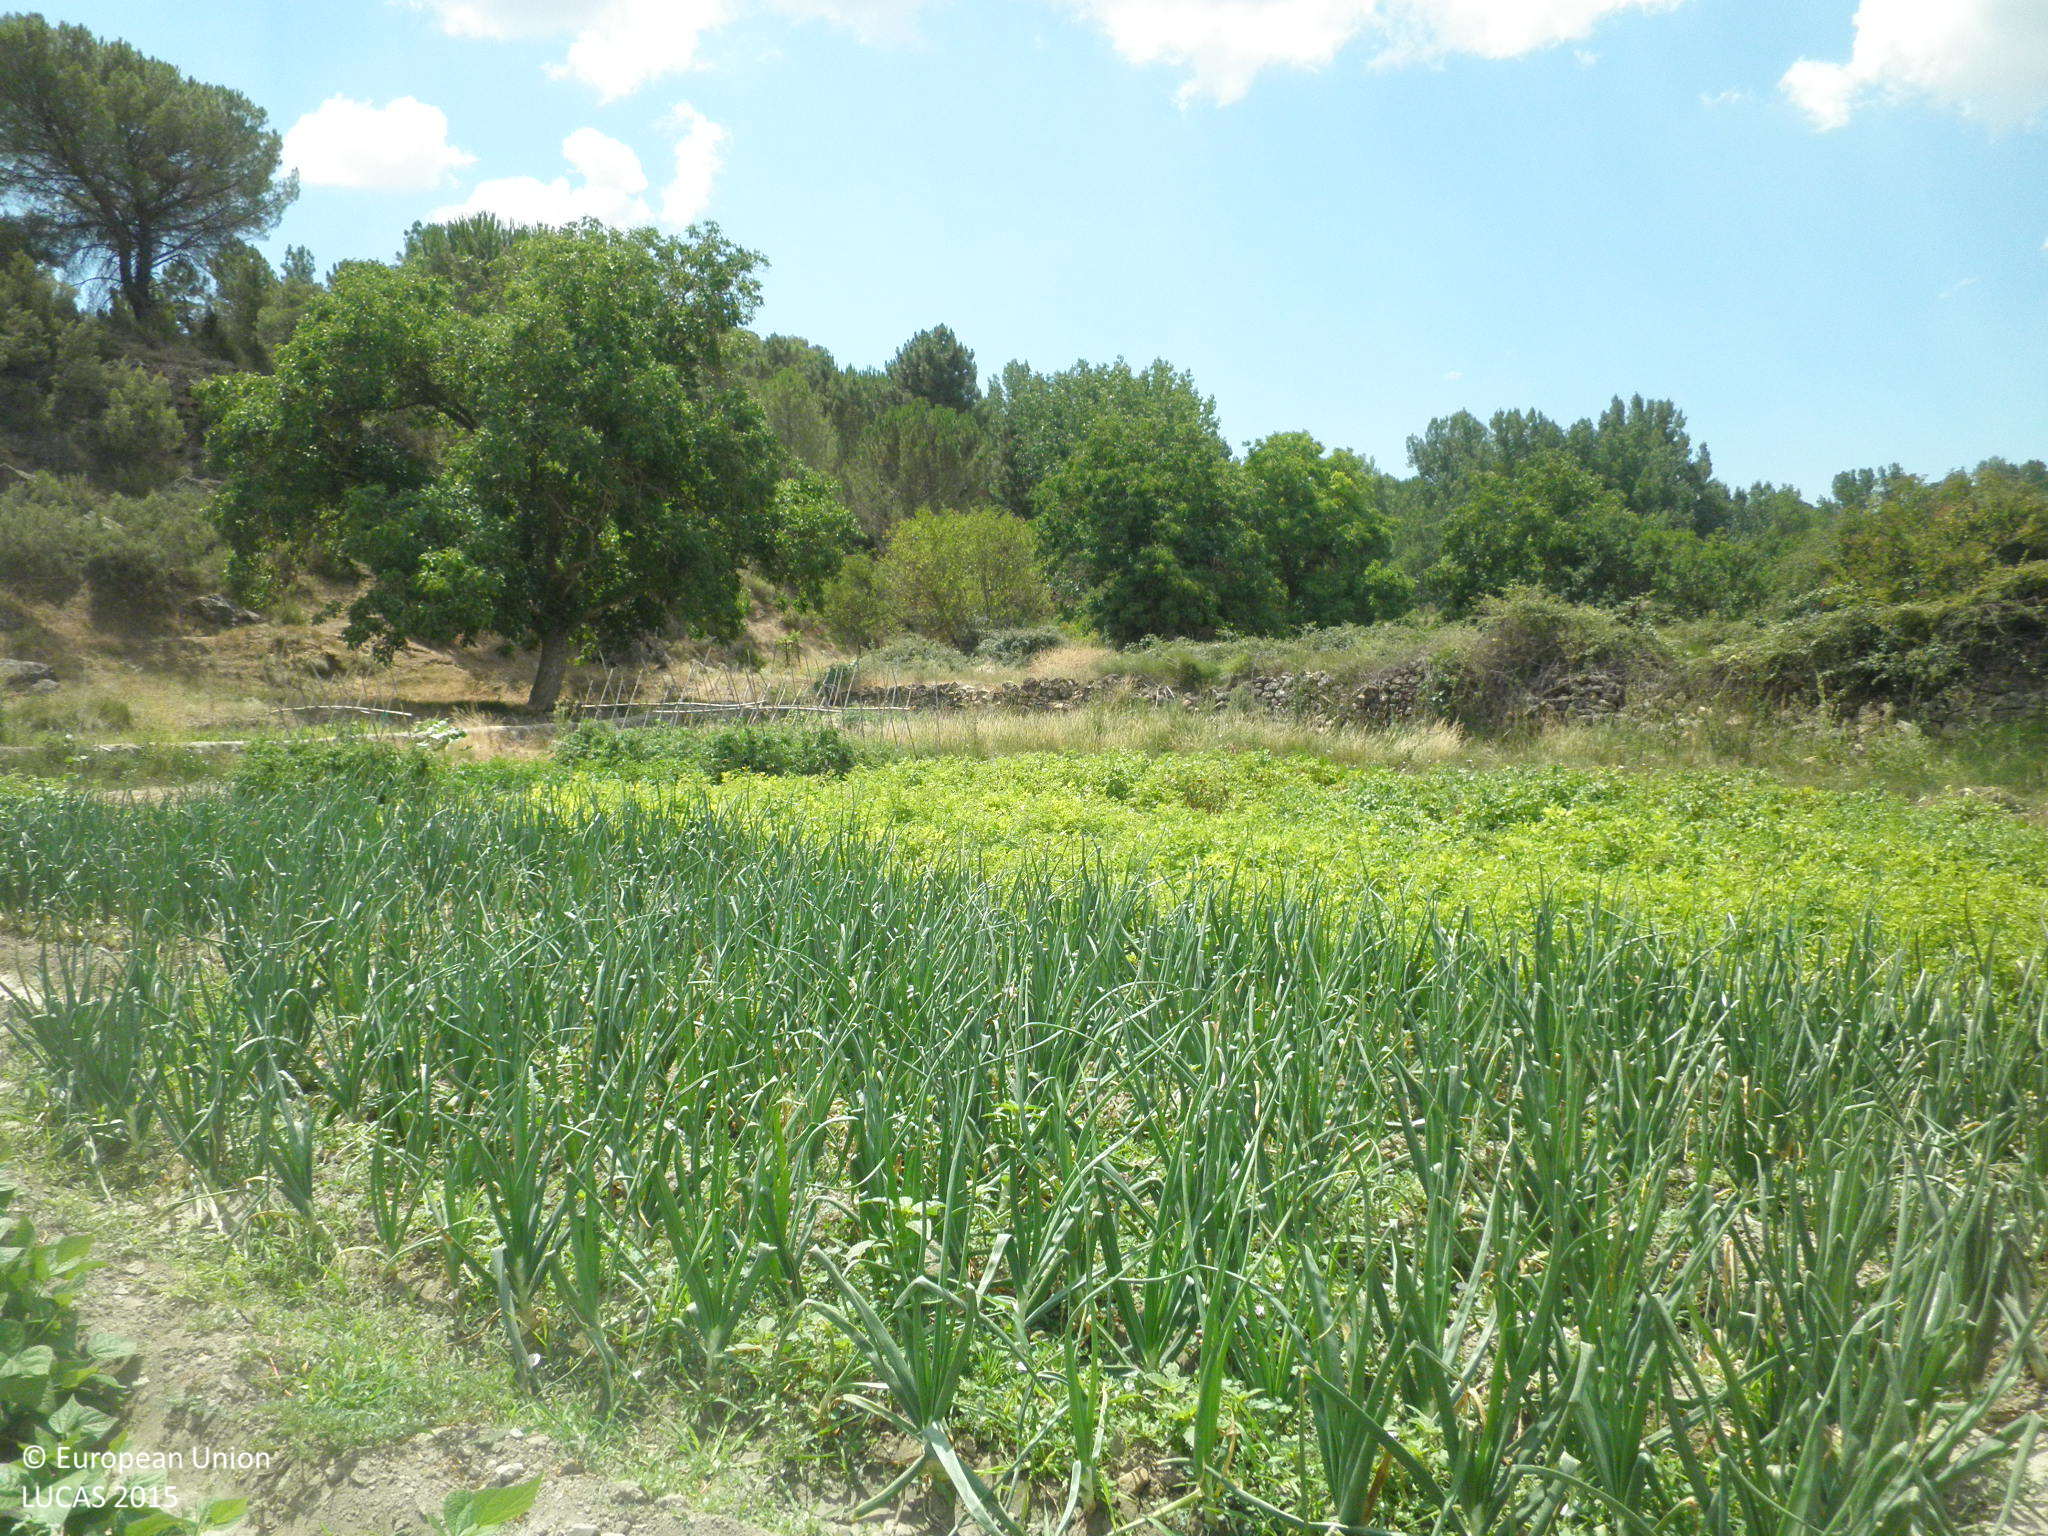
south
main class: Cropland
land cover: Other fresh vegetables
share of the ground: < 10 %
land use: Kitchen garden
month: July
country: ES
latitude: 39.7195
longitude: -1.7793
